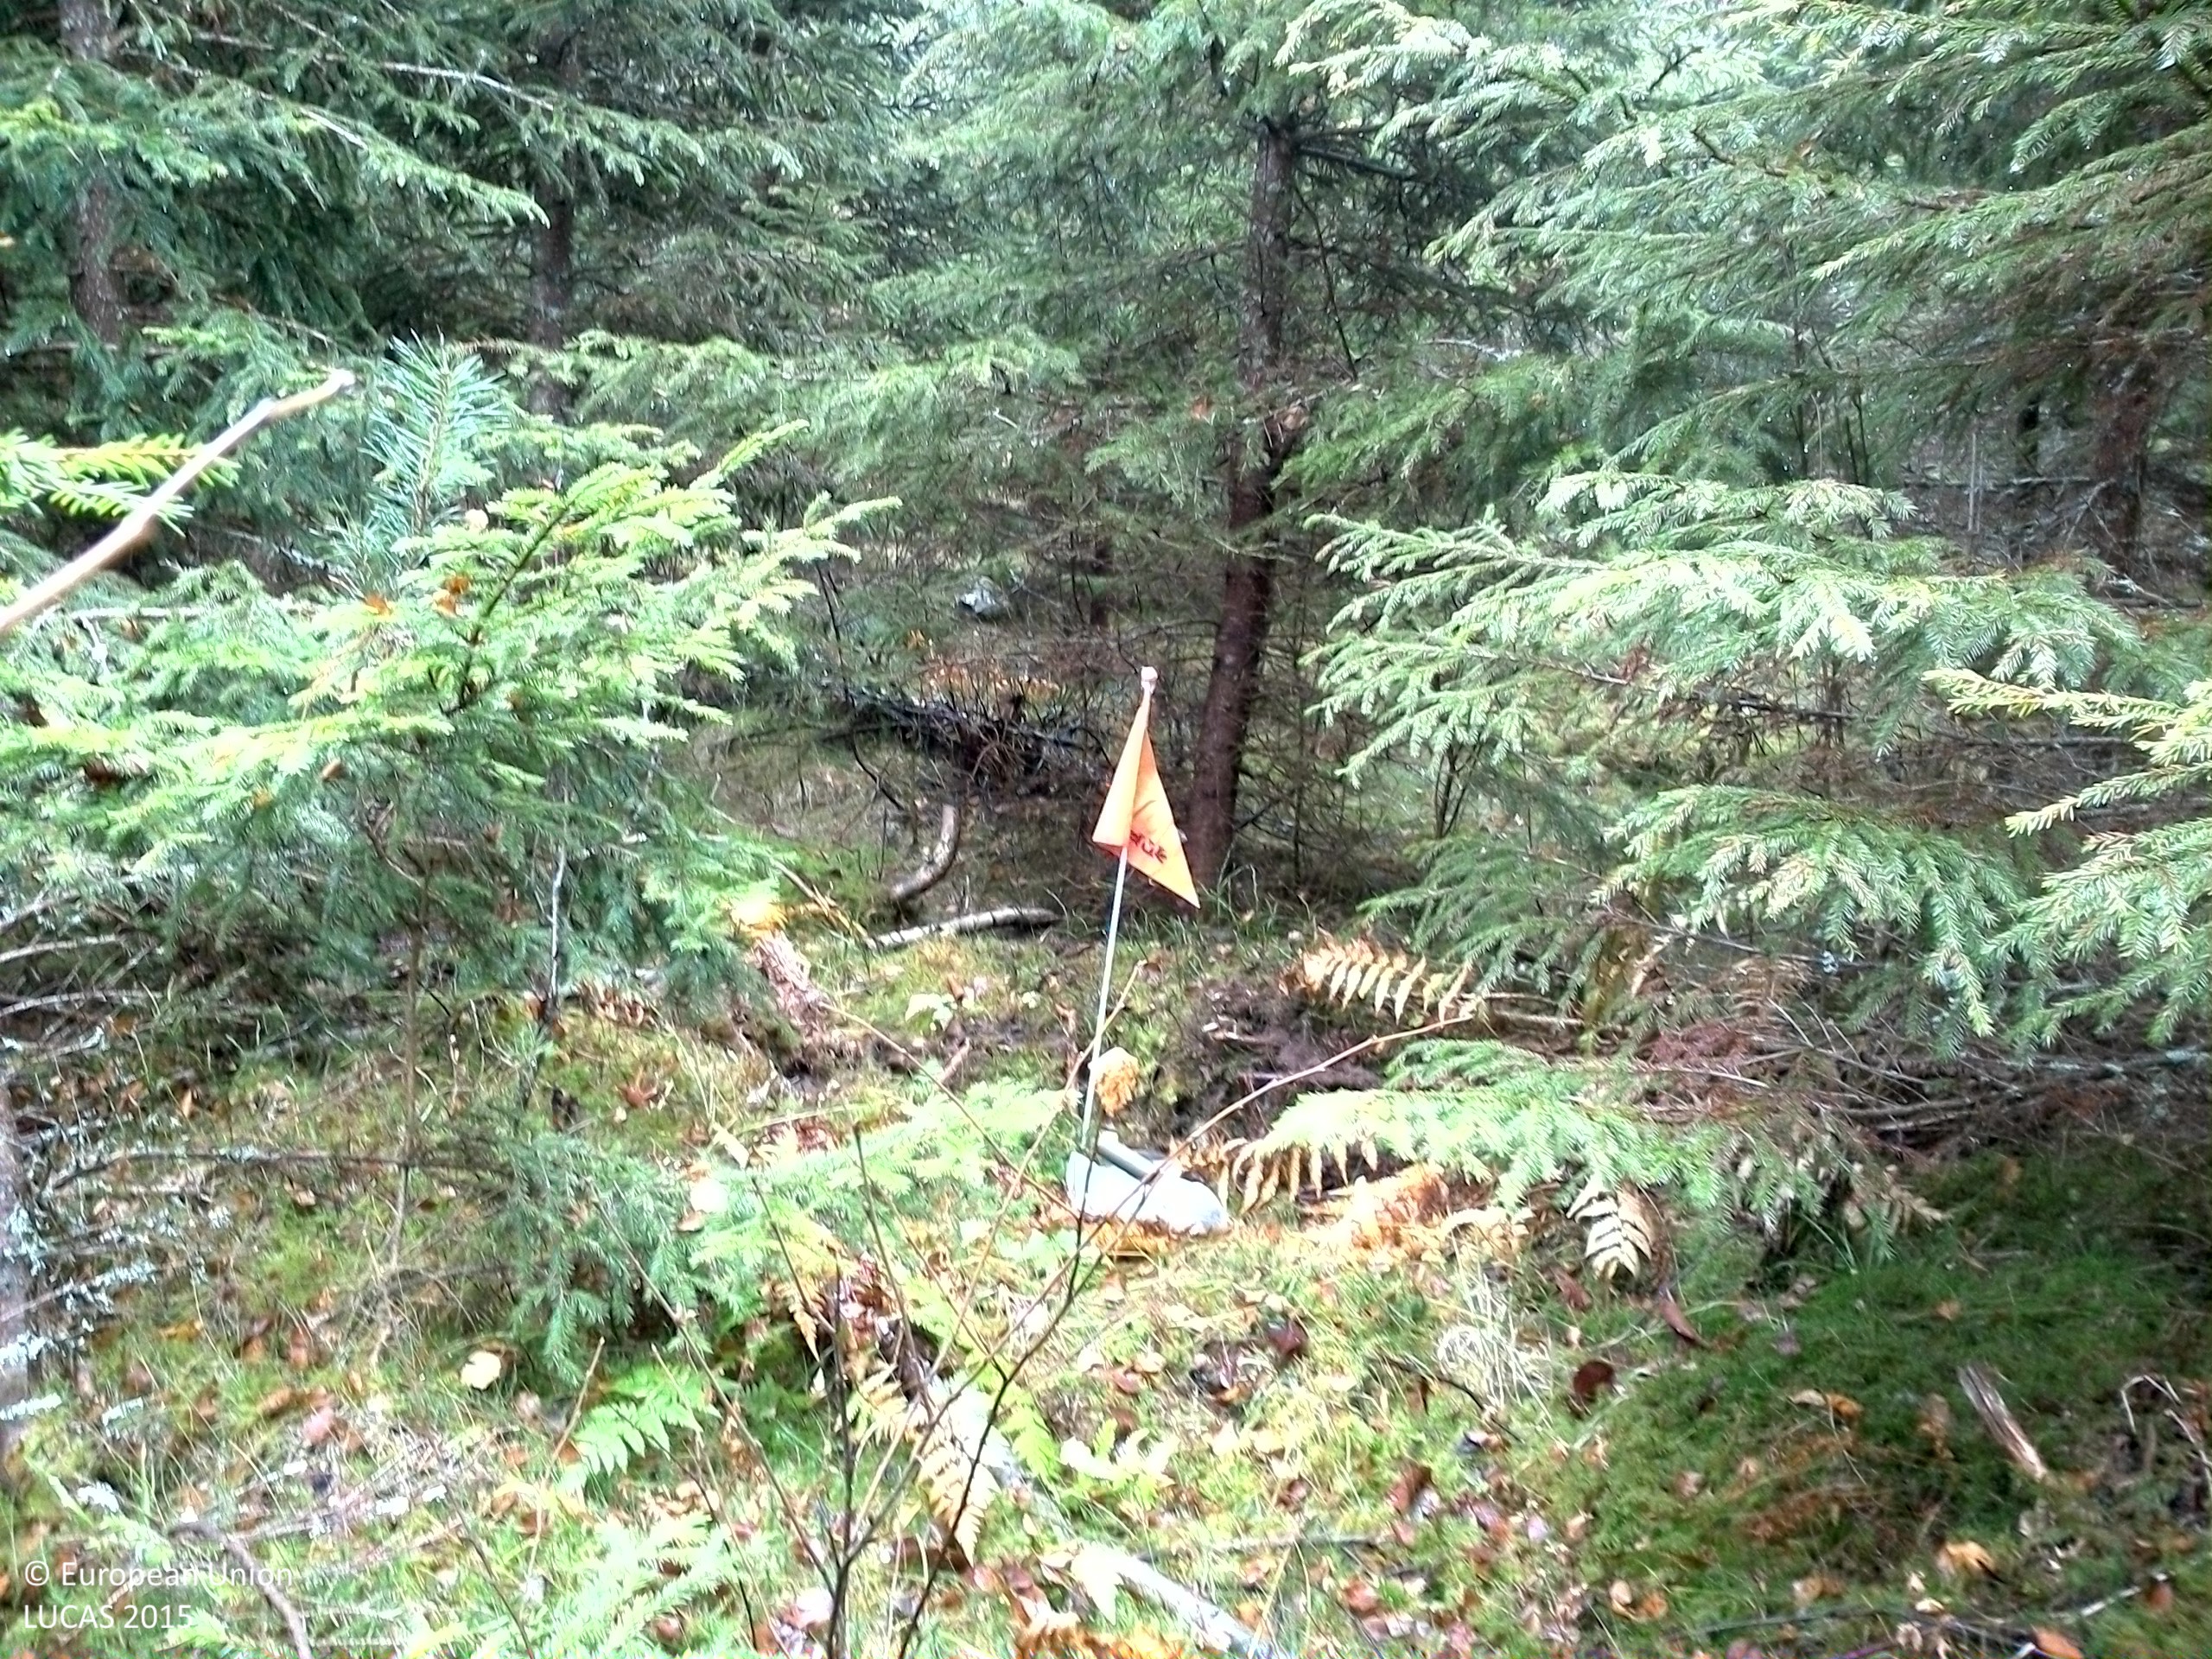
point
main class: Woodland
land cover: Spruce dominated coniferous woodland
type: boreal forest
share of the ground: > 75 %
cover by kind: coniferous forest trees 75 %, lichens and mosses 10 %, broadleaved forest trees 5 %, shrubs 5 %, herbaceous plants 5 %
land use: Forestry
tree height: < 5 m
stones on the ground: 10 - 25 %
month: November
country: SE
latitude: 57.8562
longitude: 15.0002
